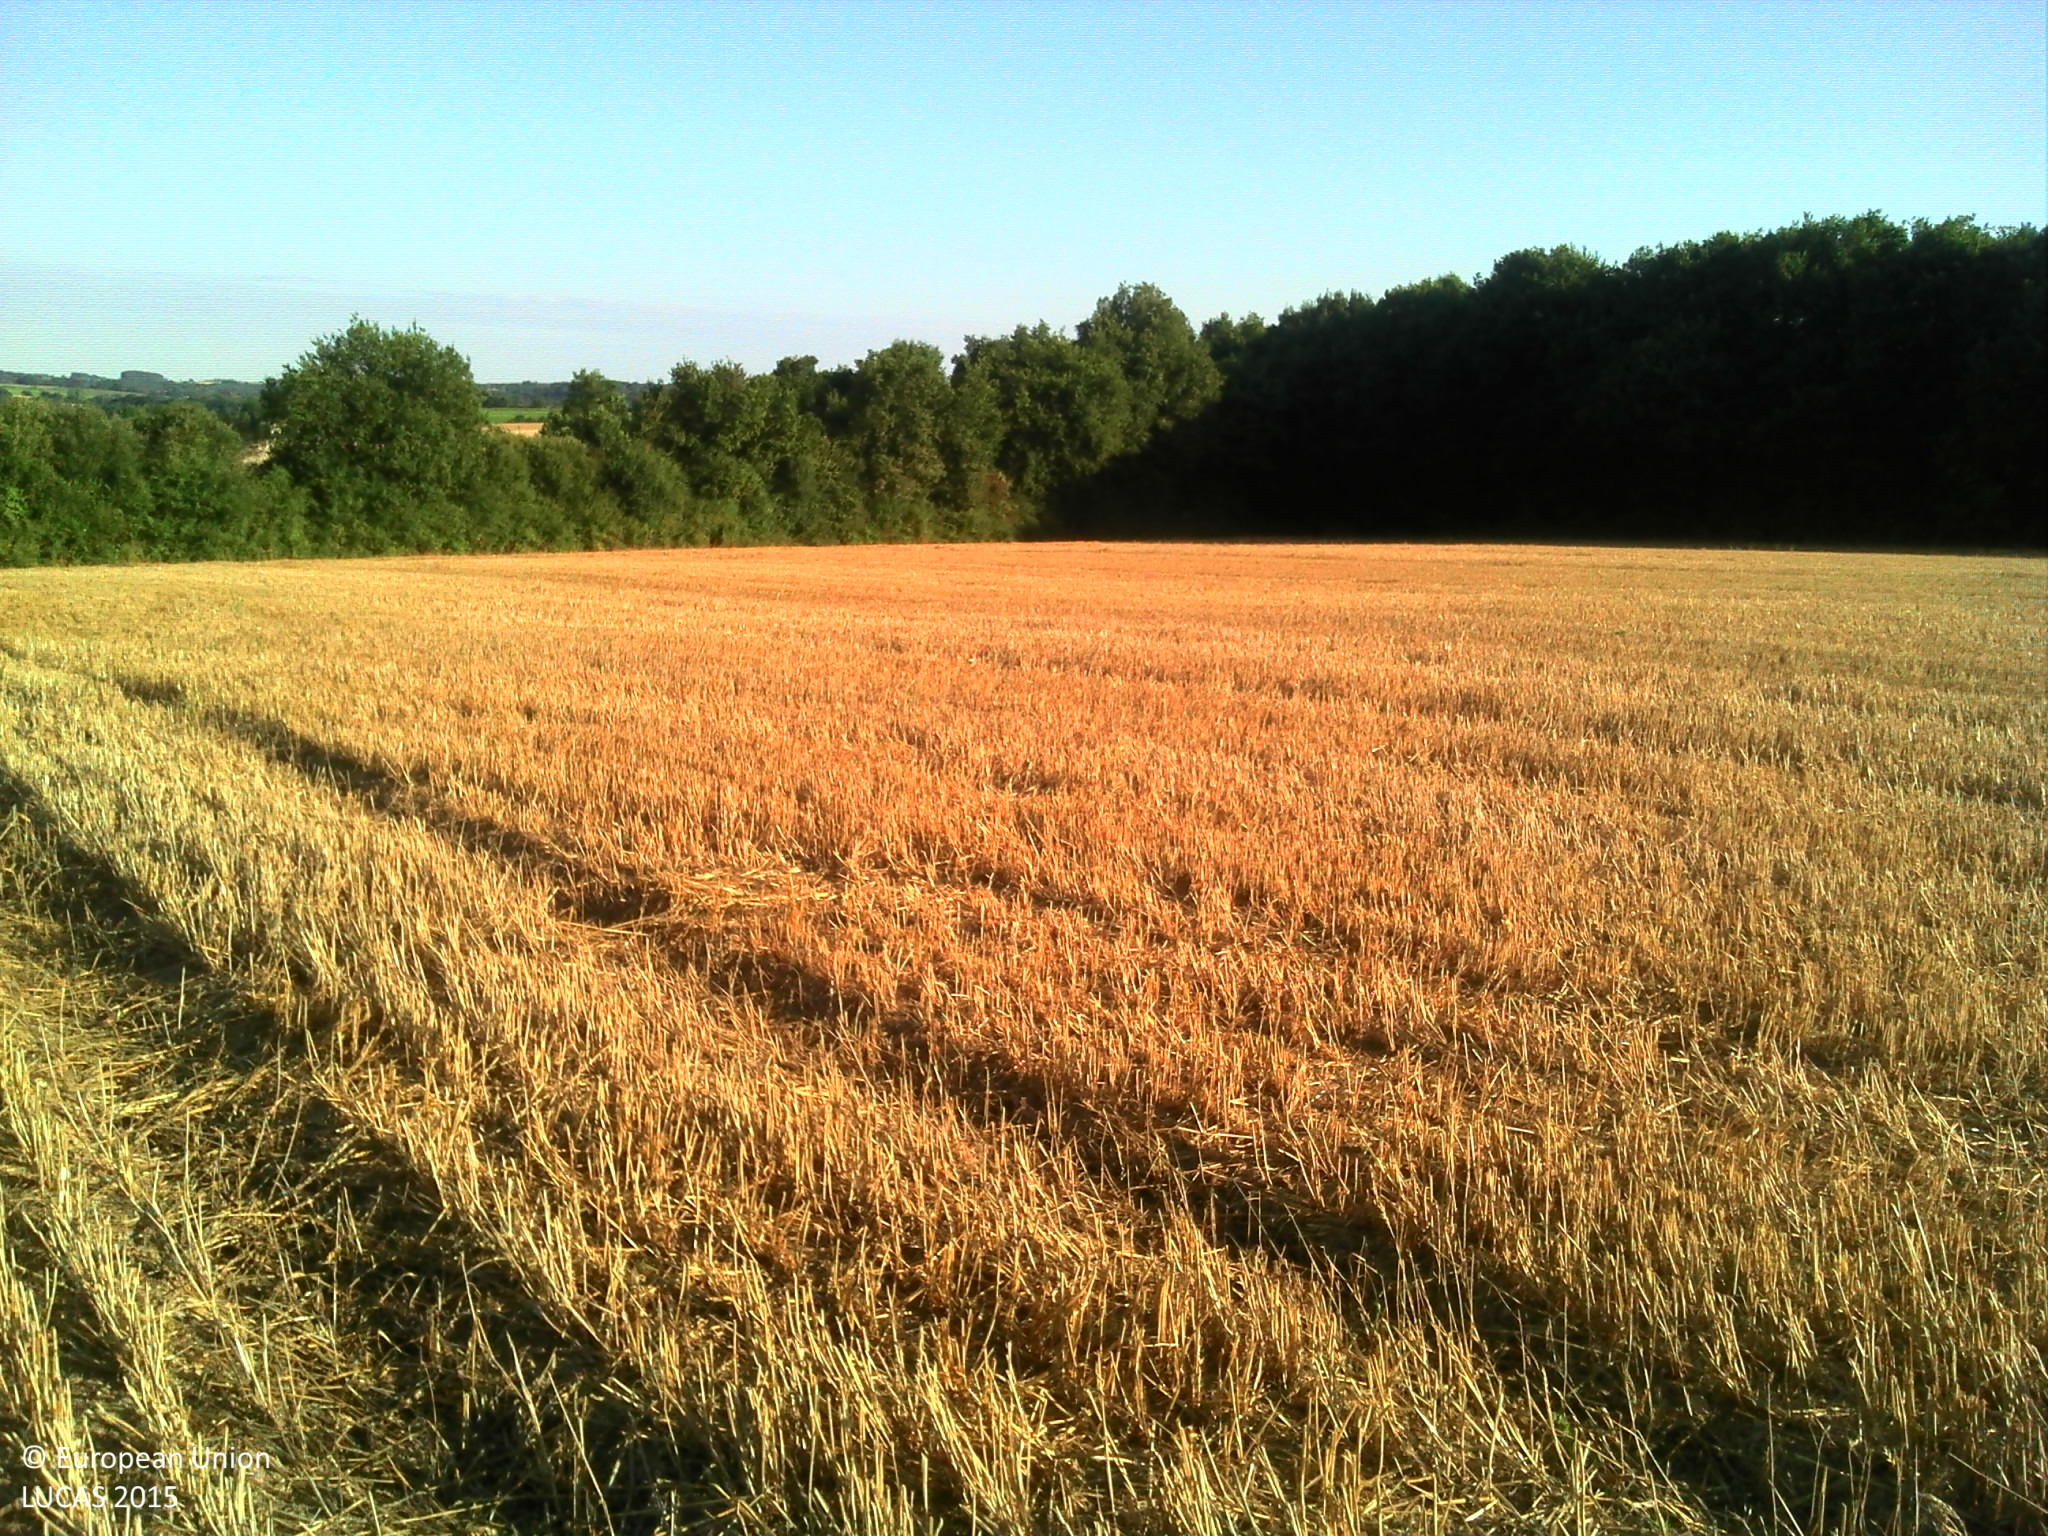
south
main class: Cropland
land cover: Common wheat
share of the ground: > 75 %
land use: Agriculture (excluding fallow land and kitchen gardens)
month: August
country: FR
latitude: 46.6439
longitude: -1.0995
